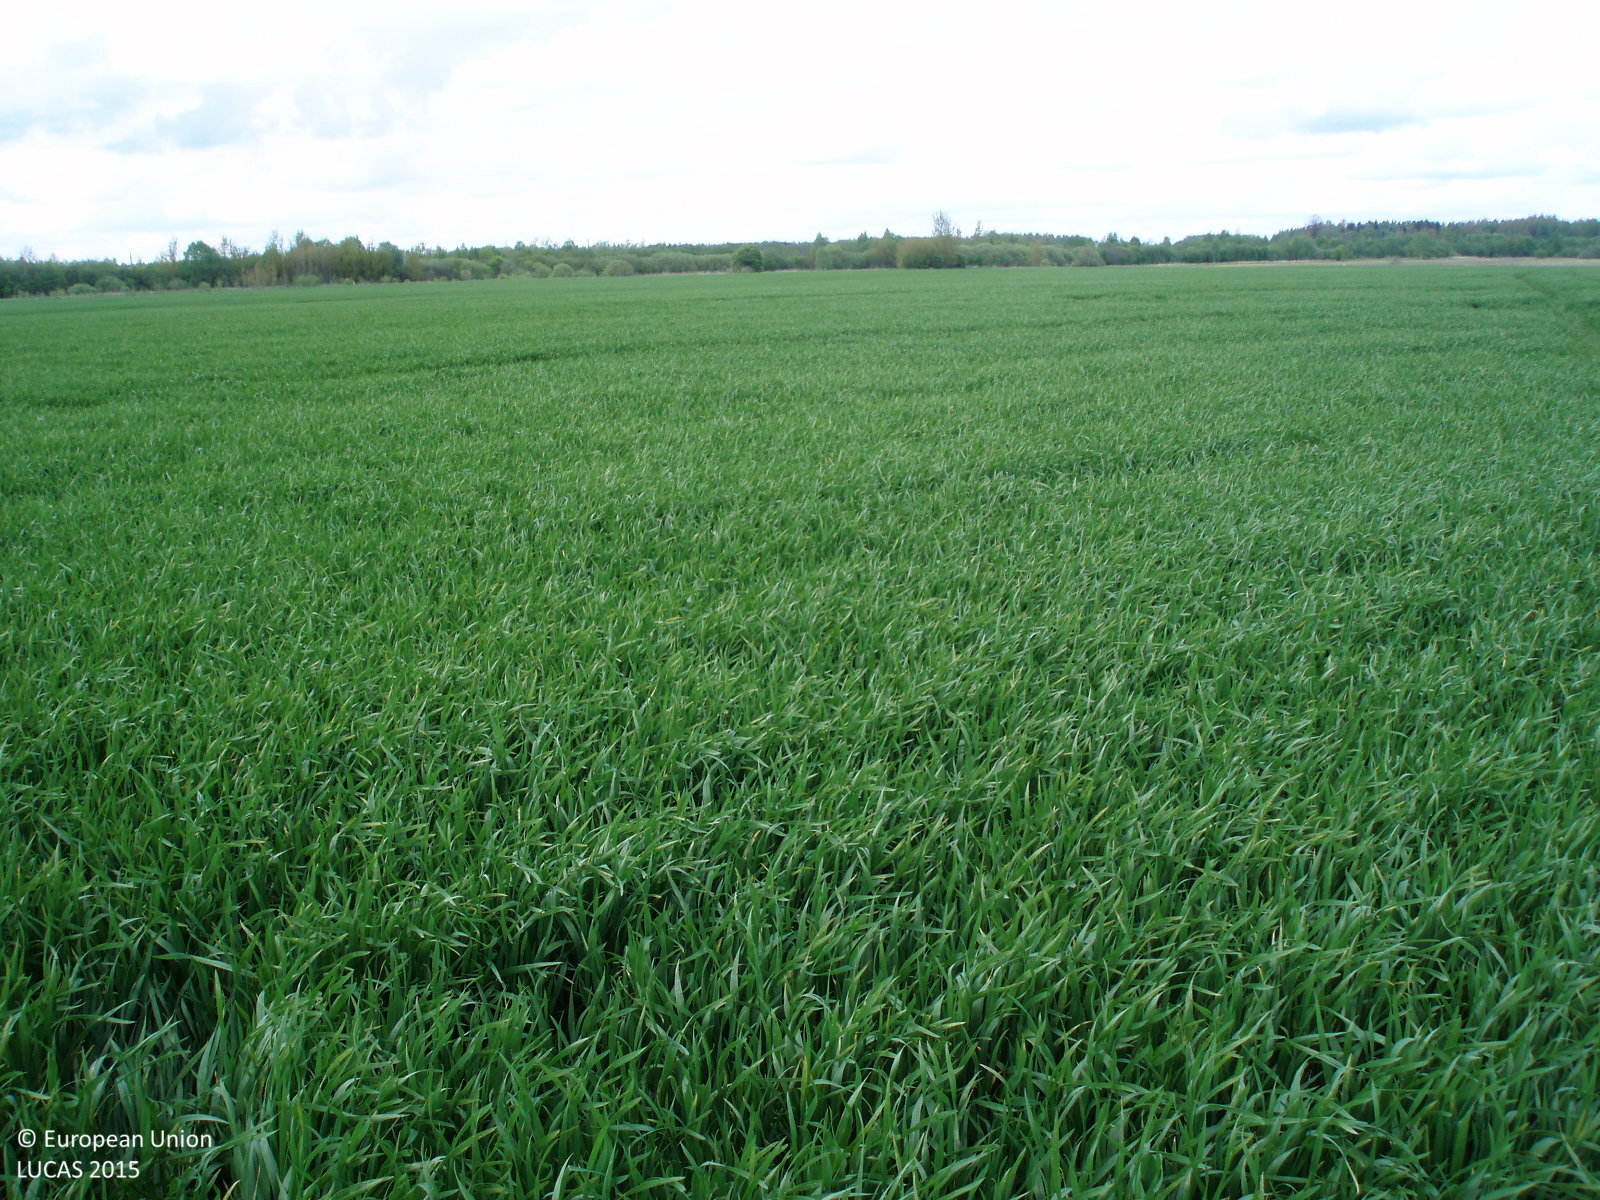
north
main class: Cropland
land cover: Common wheat
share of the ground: > 75 %
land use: Agriculture (excluding fallow land and kitchen gardens)
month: May
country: LT
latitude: 56.3421
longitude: 22.4659
